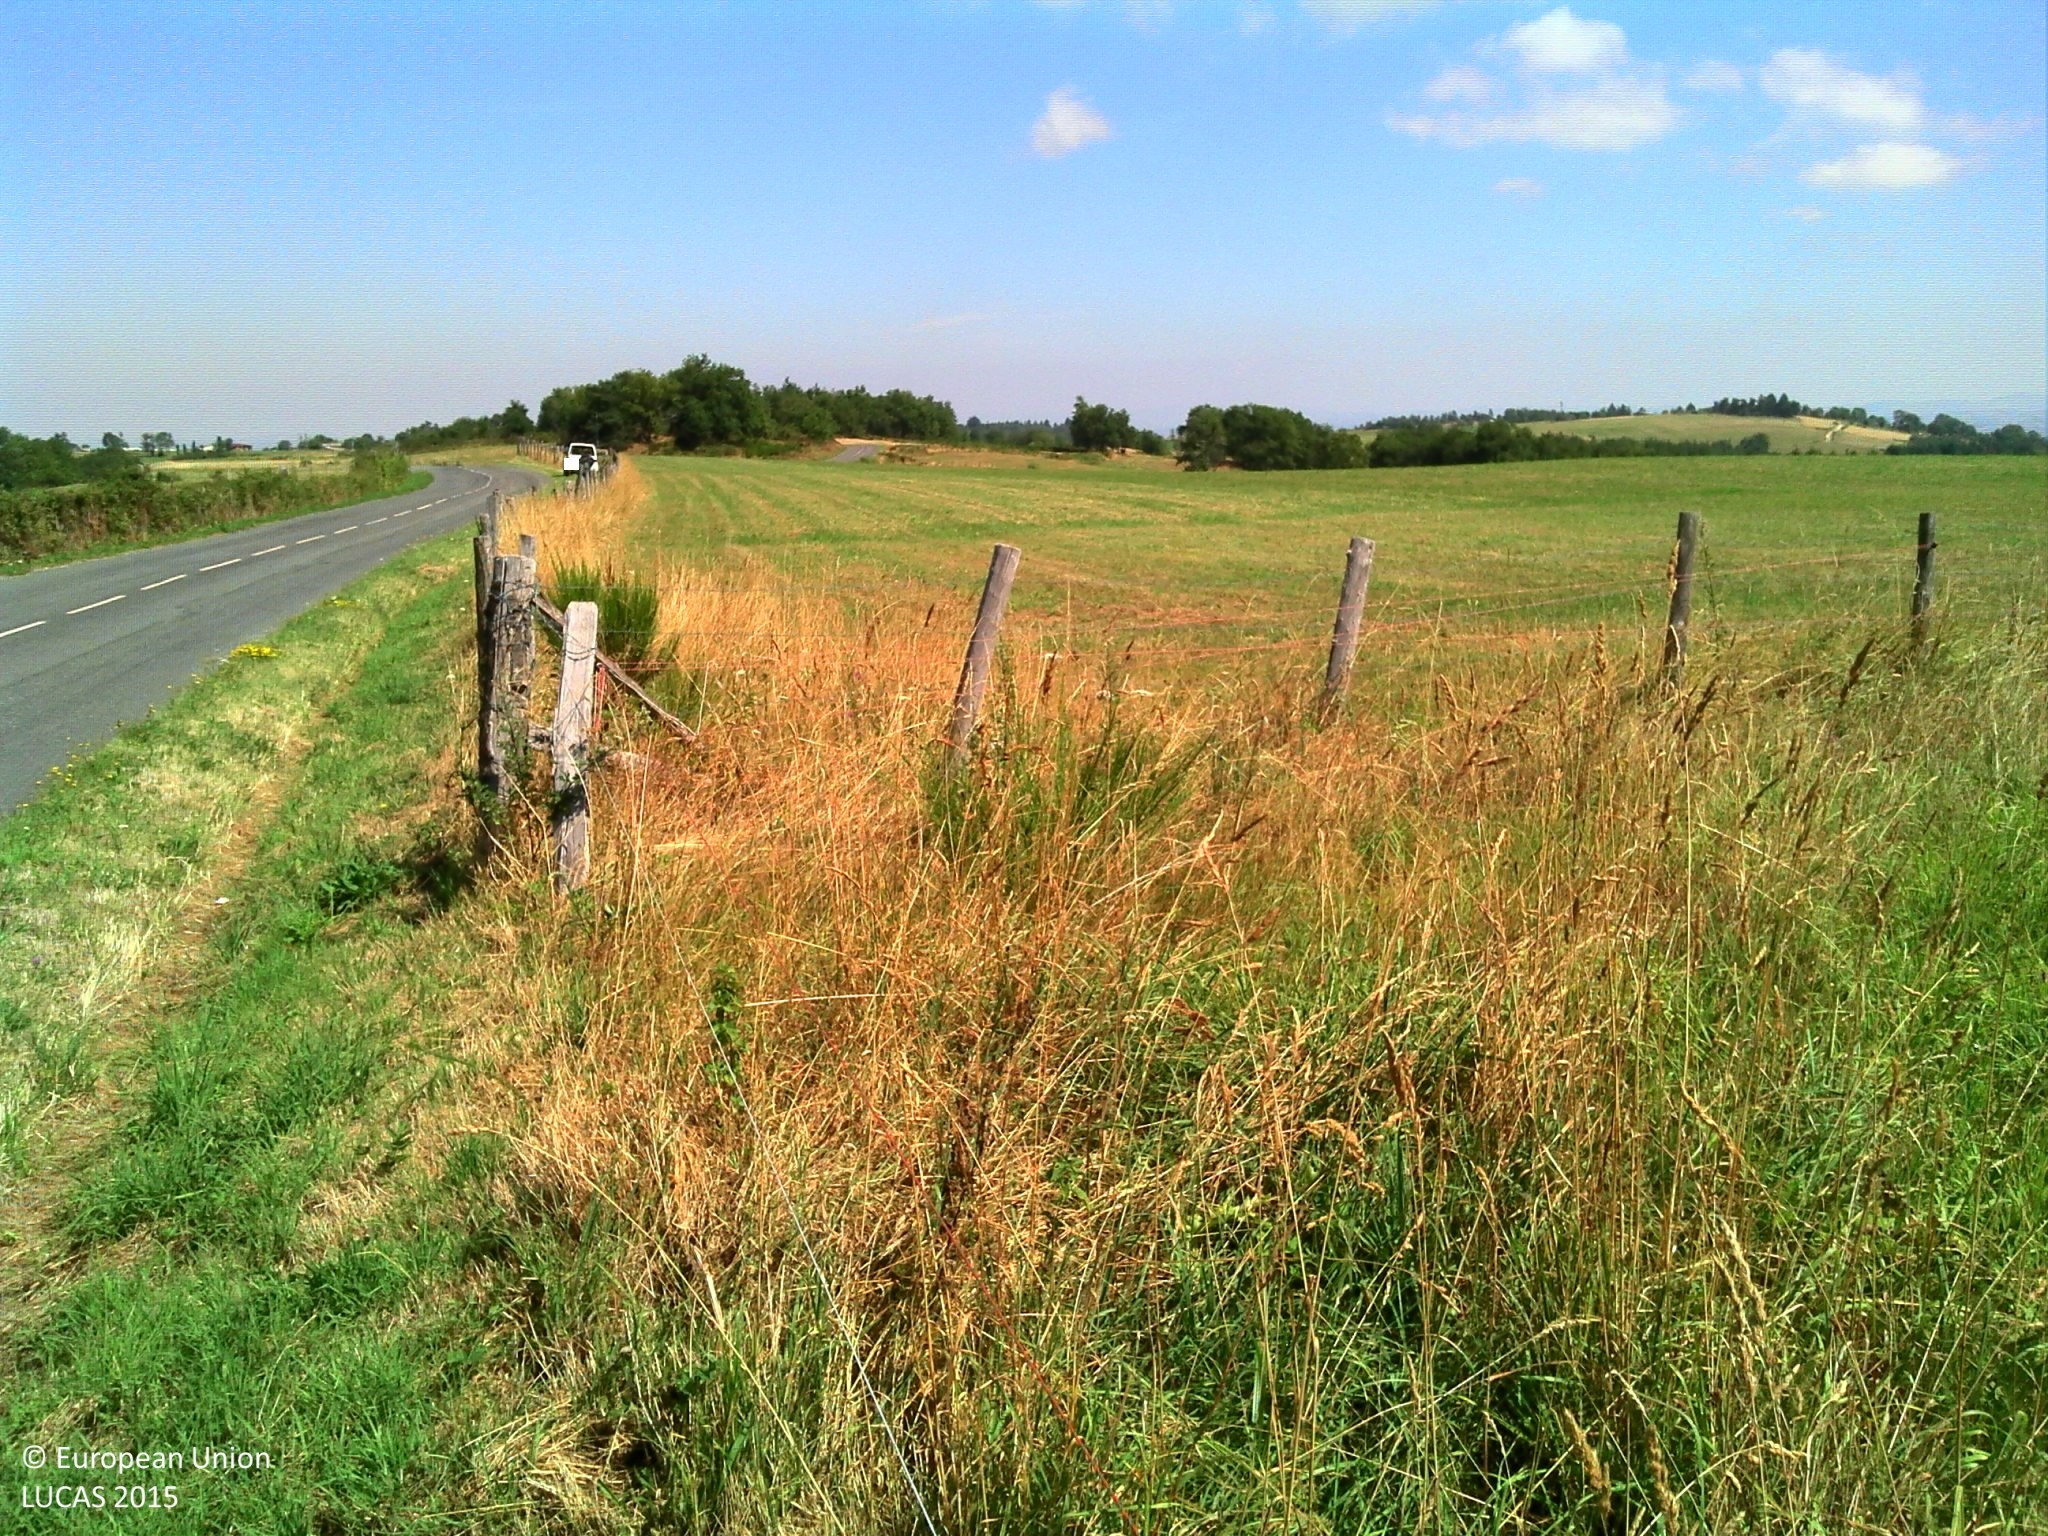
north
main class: Grassland
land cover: Grassland without tree/shrub cover
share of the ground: > 75 %
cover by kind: herbaceous plants 100 %
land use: Agriculture (excluding fallow land and kitchen gardens)
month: August
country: FR
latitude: 45.4180
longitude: 4.2146
